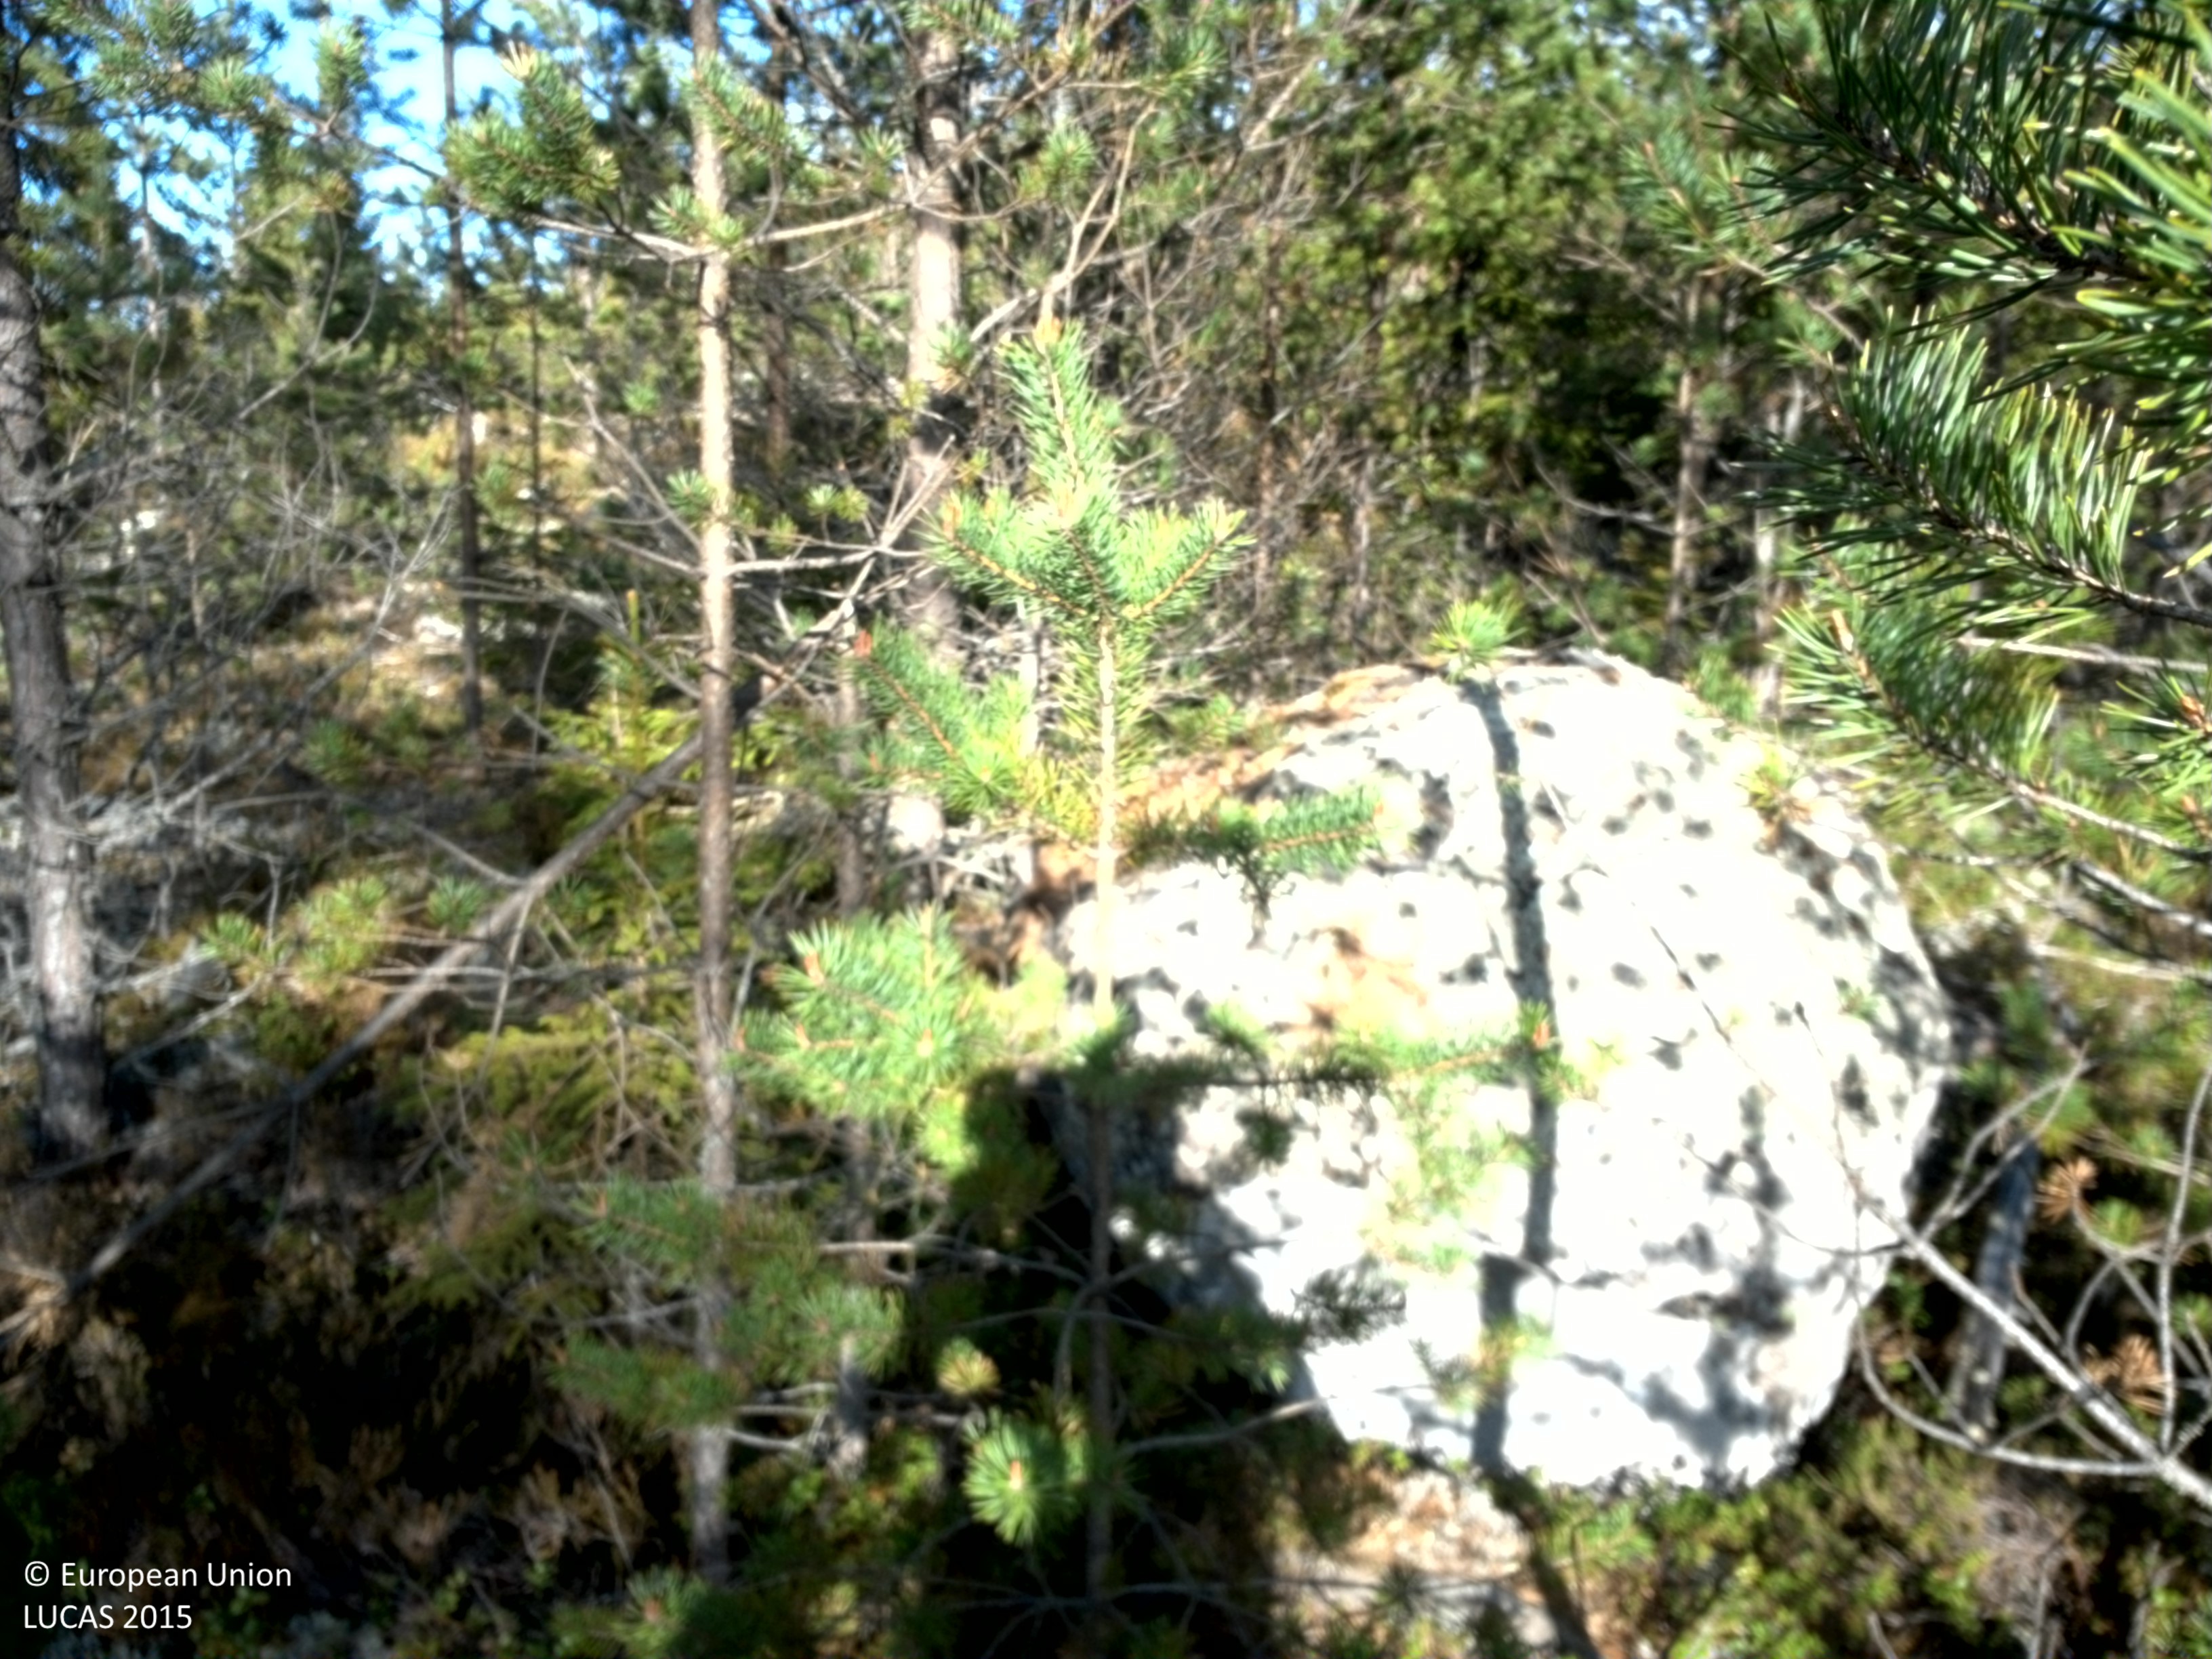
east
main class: Woodland
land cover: Pine dominated coniferous woodland
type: boreal forest
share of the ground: > 75 %
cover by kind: coniferous forest trees 80 %, shrubs 10 %, lichens and mosses 10 %
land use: Forestry
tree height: > 5 m
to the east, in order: Pine dominated coniferous woodland; Other coniferous woodland; Spruce dominated coniferous woodland
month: May
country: SE
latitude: 60.2878
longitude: 13.2284
